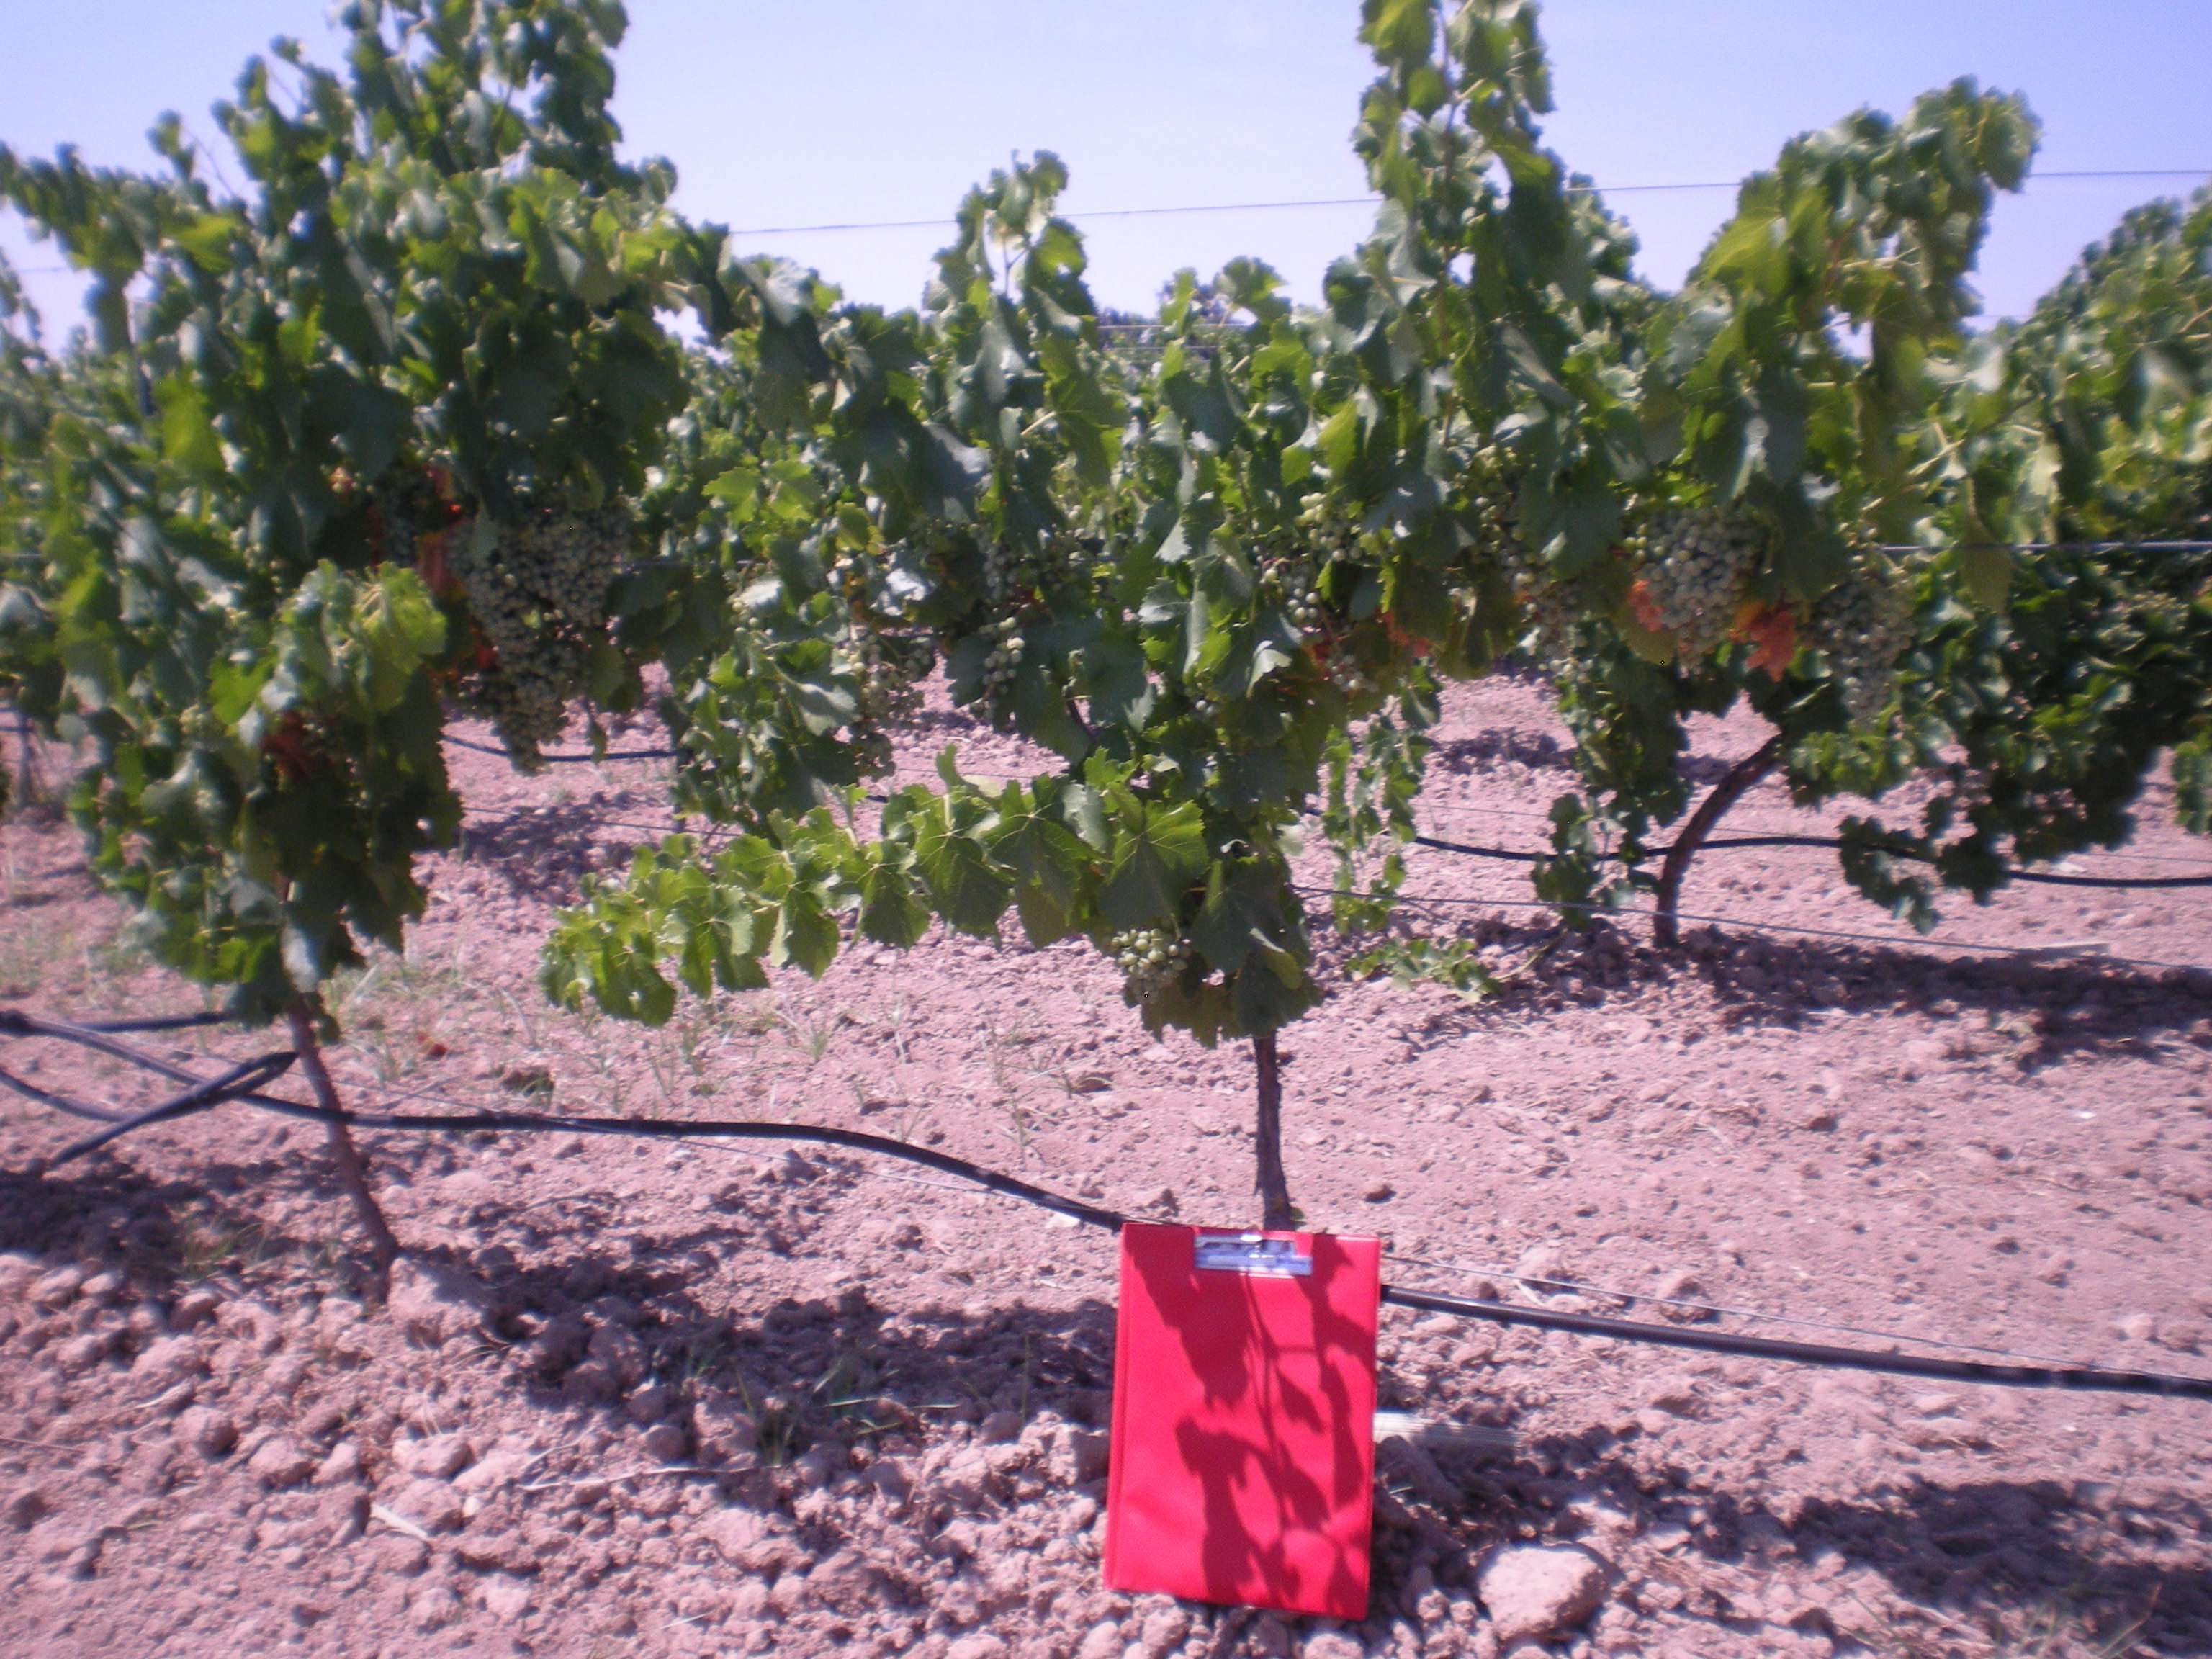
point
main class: Cropland
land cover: Vineyards
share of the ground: 25 - 50 %
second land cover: Spontaneously vegetated surfaces
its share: 10 - 25 %
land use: Agriculture (excluding fallow land and kitchen gardens)
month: July
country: ES
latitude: 39.3460
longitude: -3.1165
